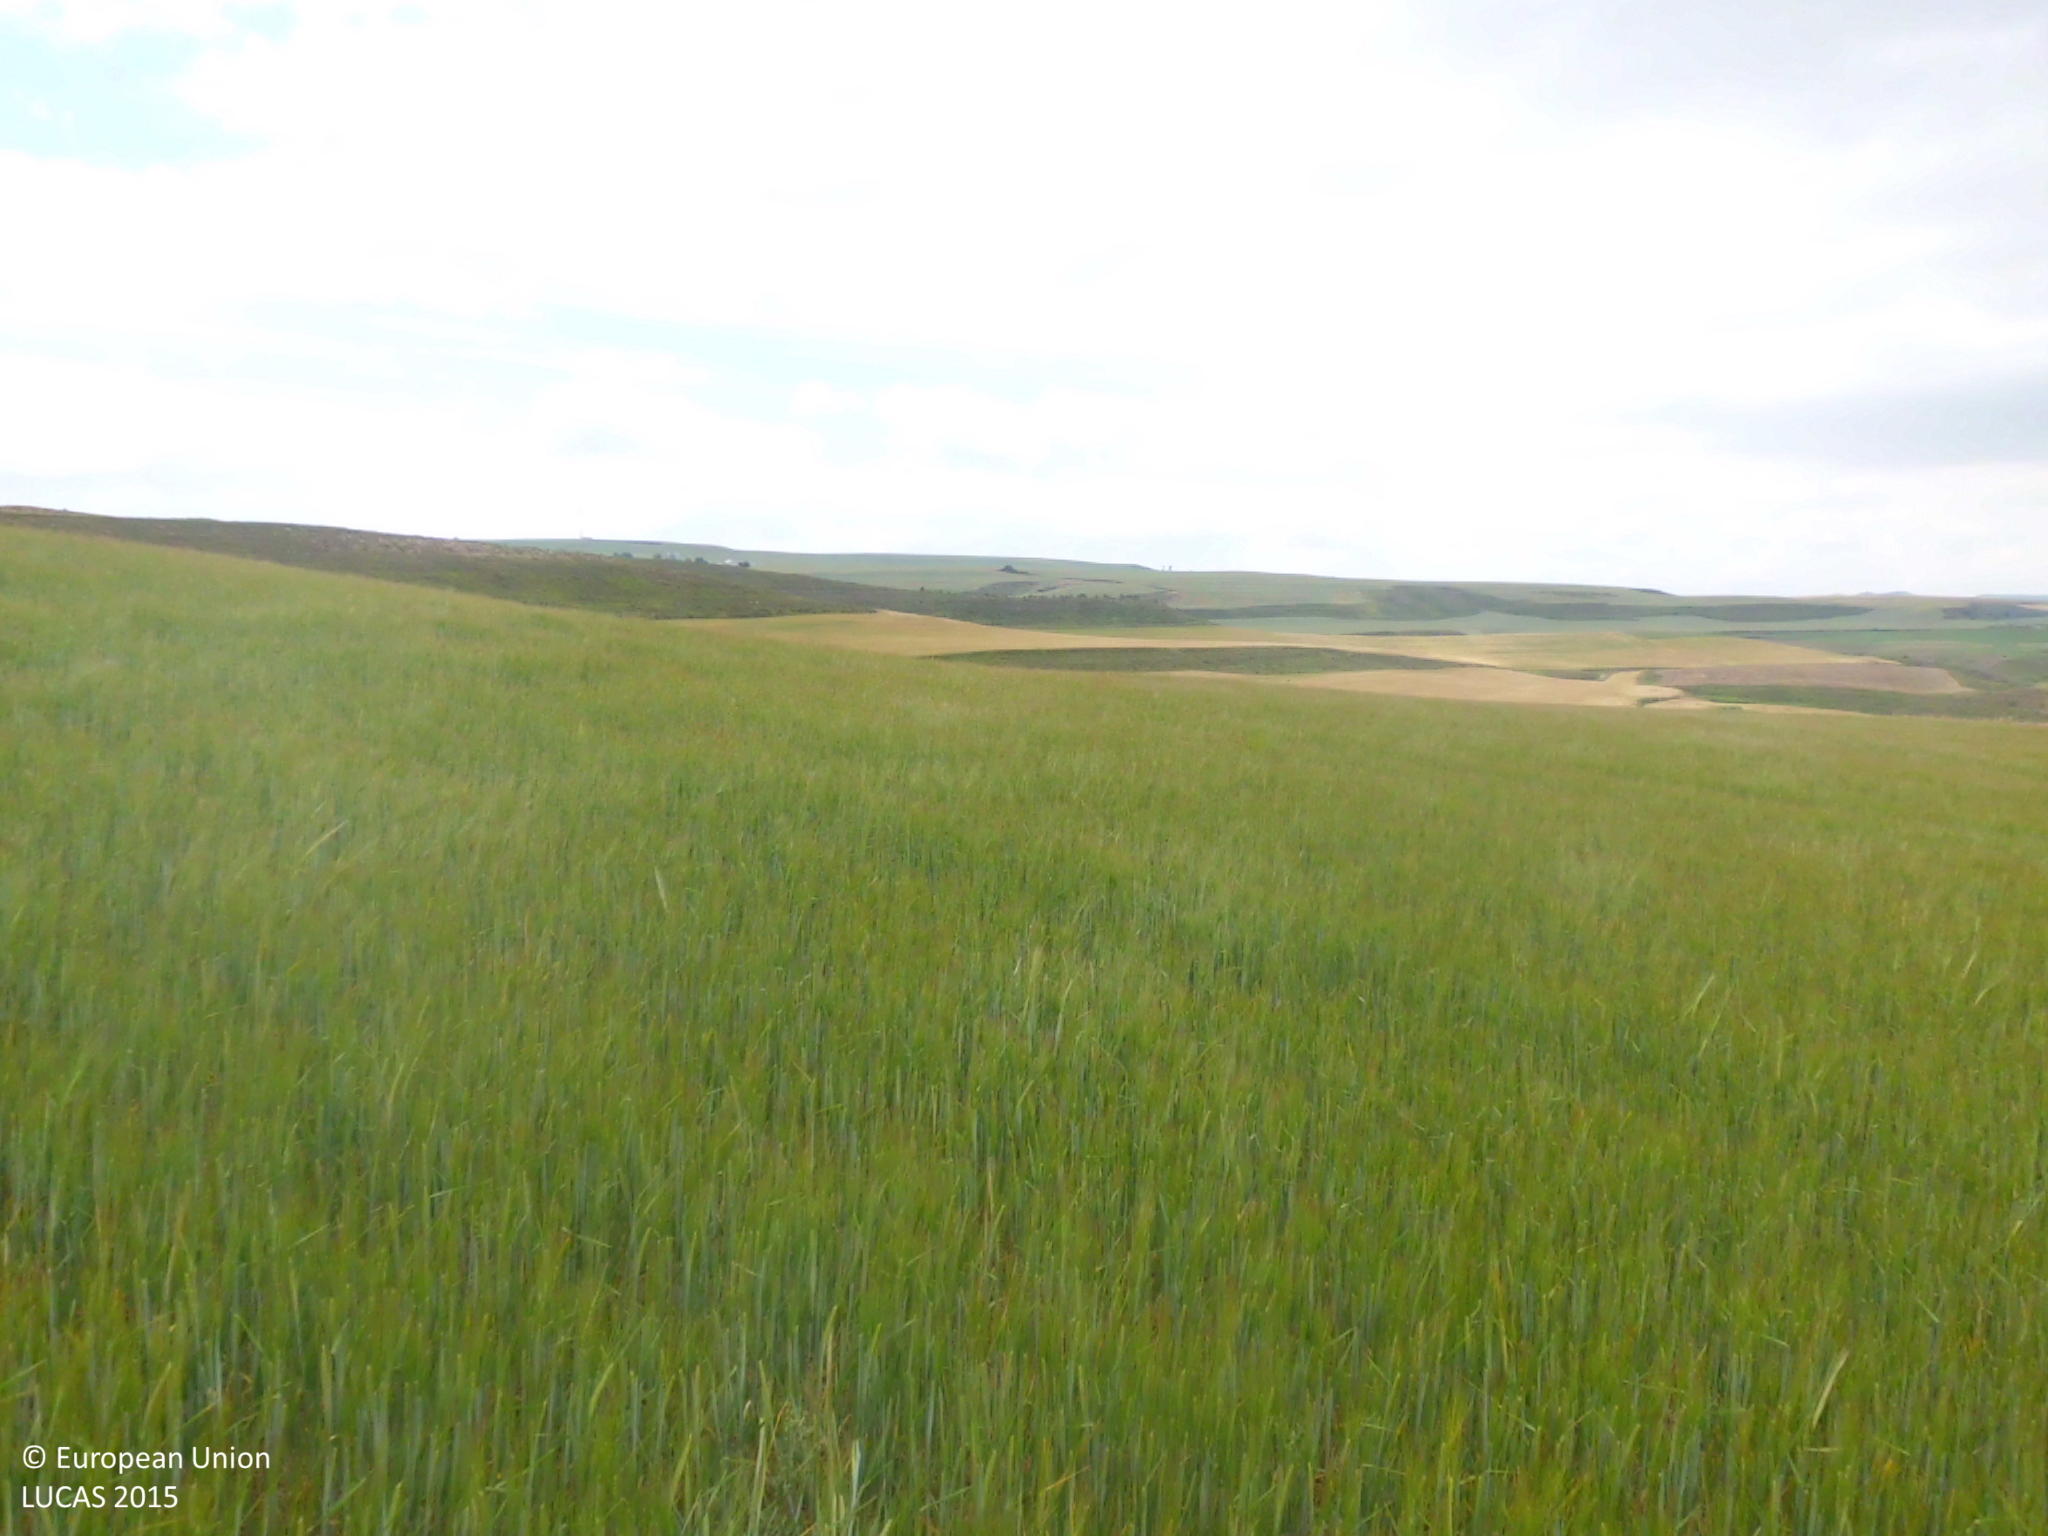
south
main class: Cropland
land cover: Barley
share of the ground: > 75 %
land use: Agriculture (excluding fallow land and kitchen gardens)
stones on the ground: < 10 %
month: June
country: ES
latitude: 42.5203
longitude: -3.3125
